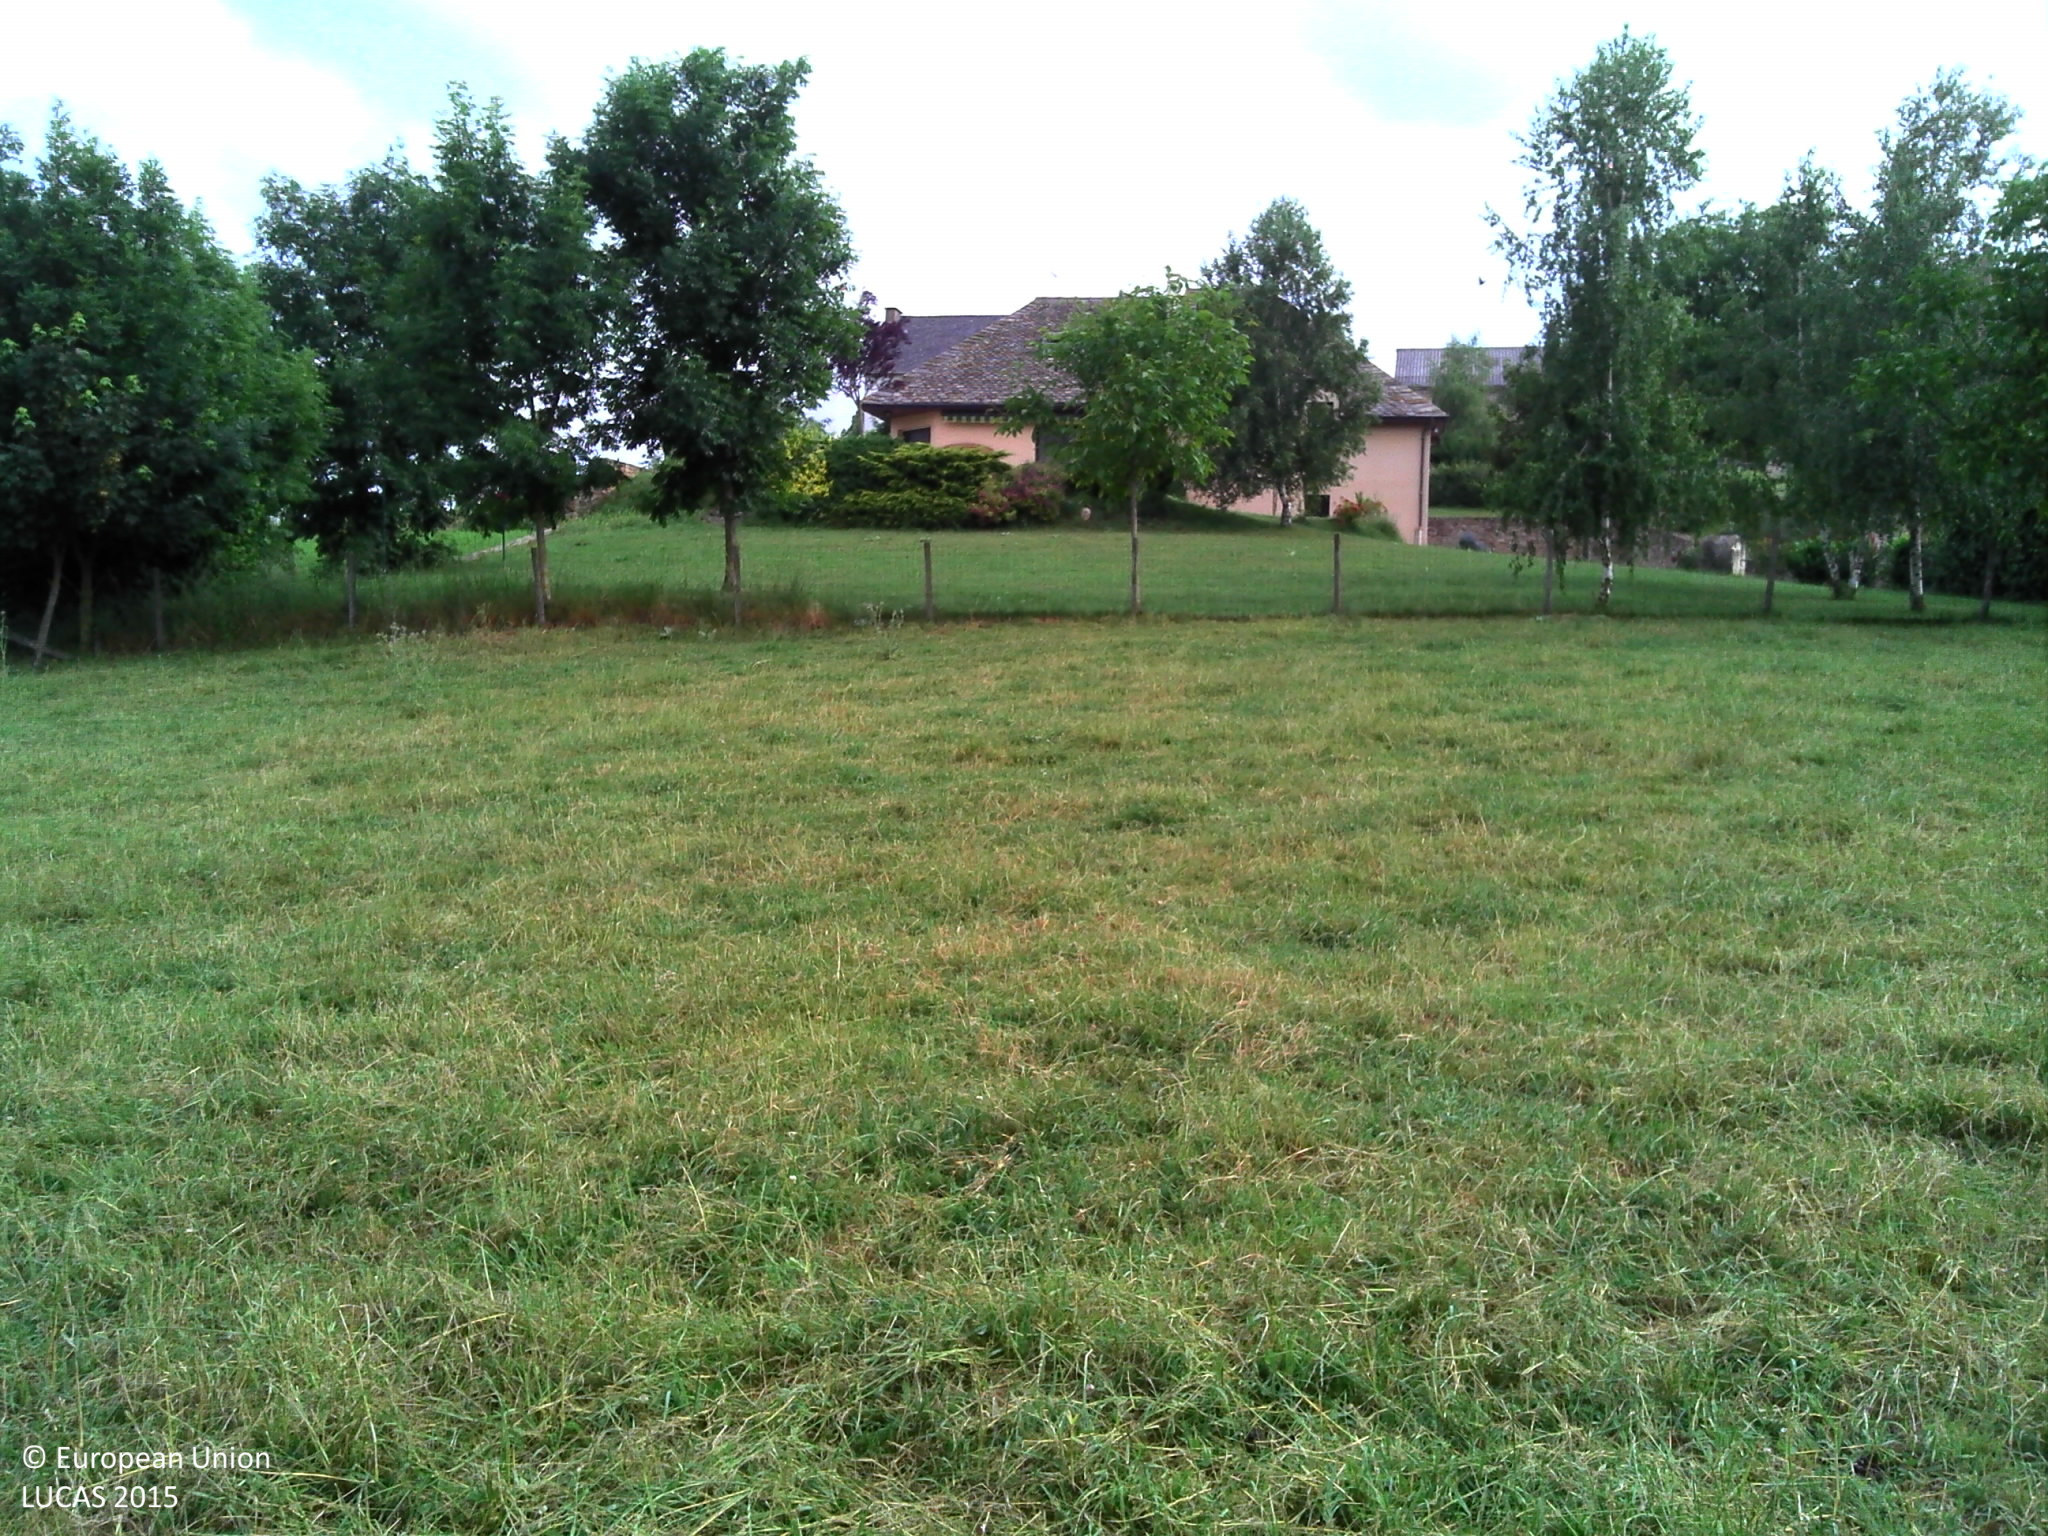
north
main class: Cropland
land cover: Temporary grasslands
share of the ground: > 75 %
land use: Agriculture (excluding fallow land and kitchen gardens)
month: June
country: FR
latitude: 44.2296
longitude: 2.5800
